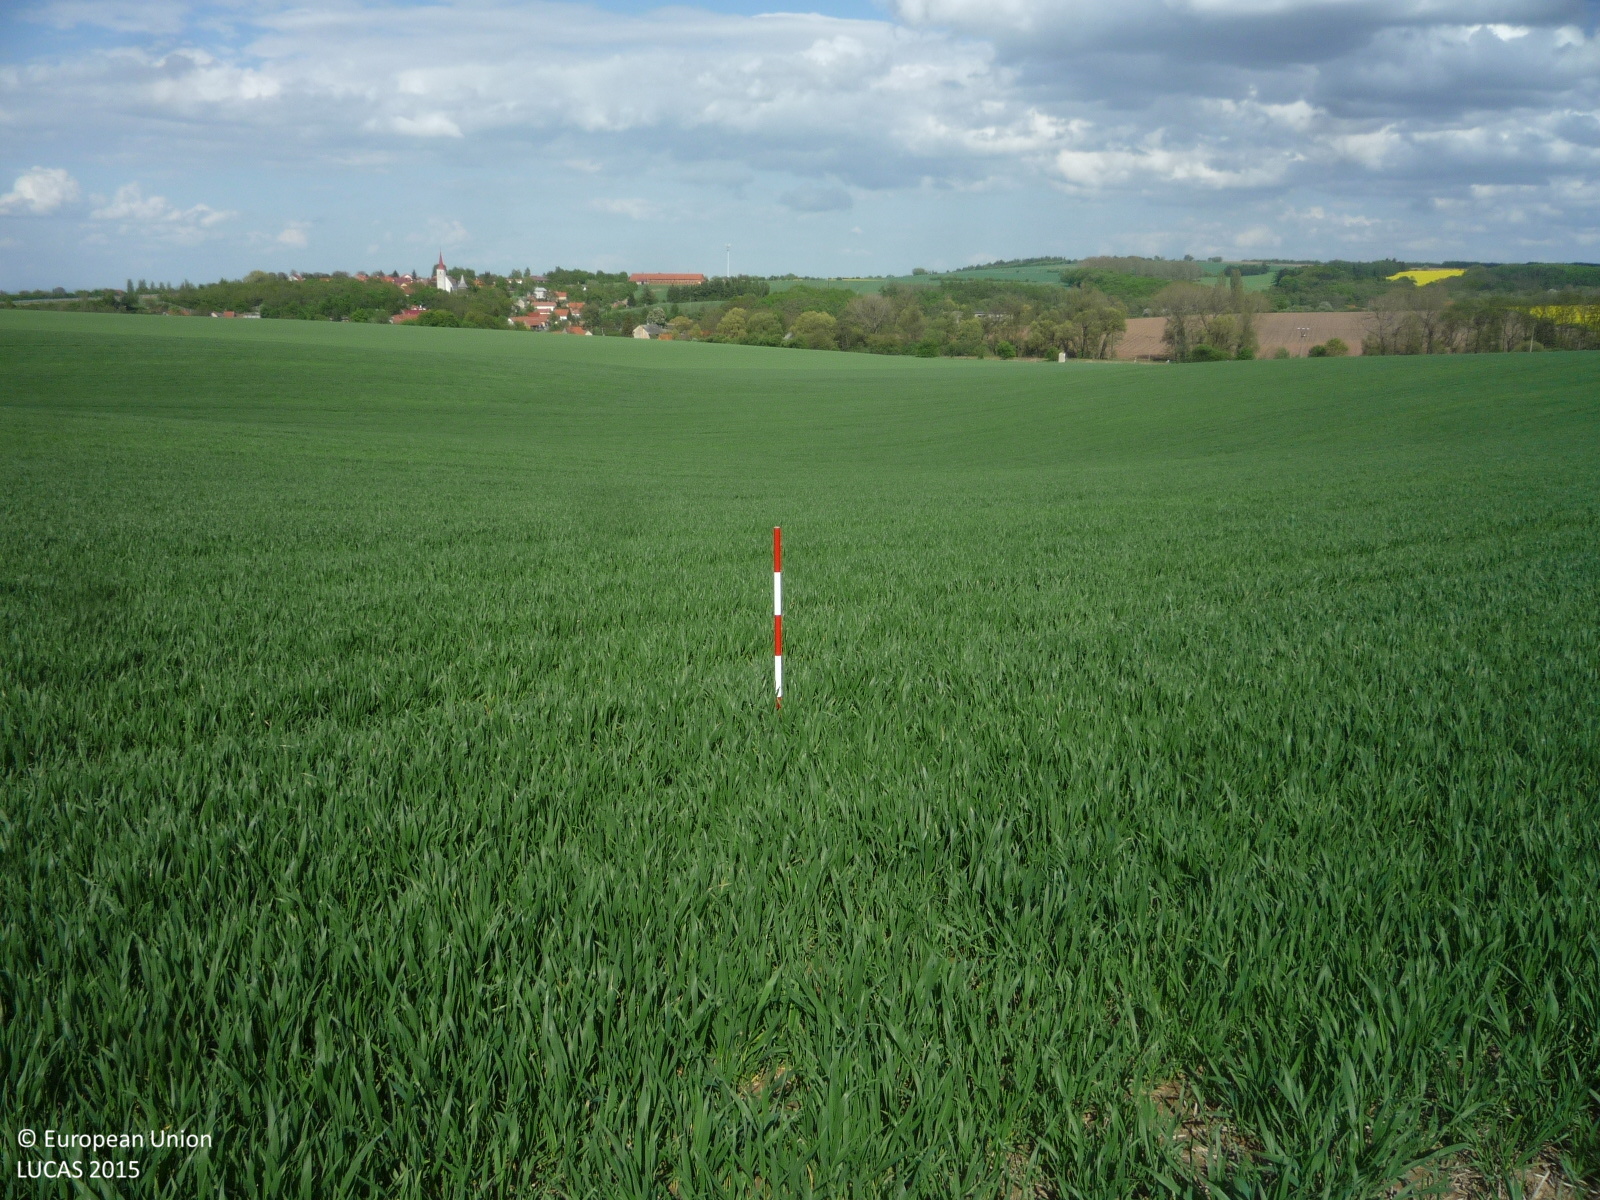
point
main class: Cropland
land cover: Common wheat
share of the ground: > 75 %
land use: Agriculture (excluding fallow land and kitchen gardens)
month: May
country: CZ
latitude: 50.0248
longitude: 14.9019
